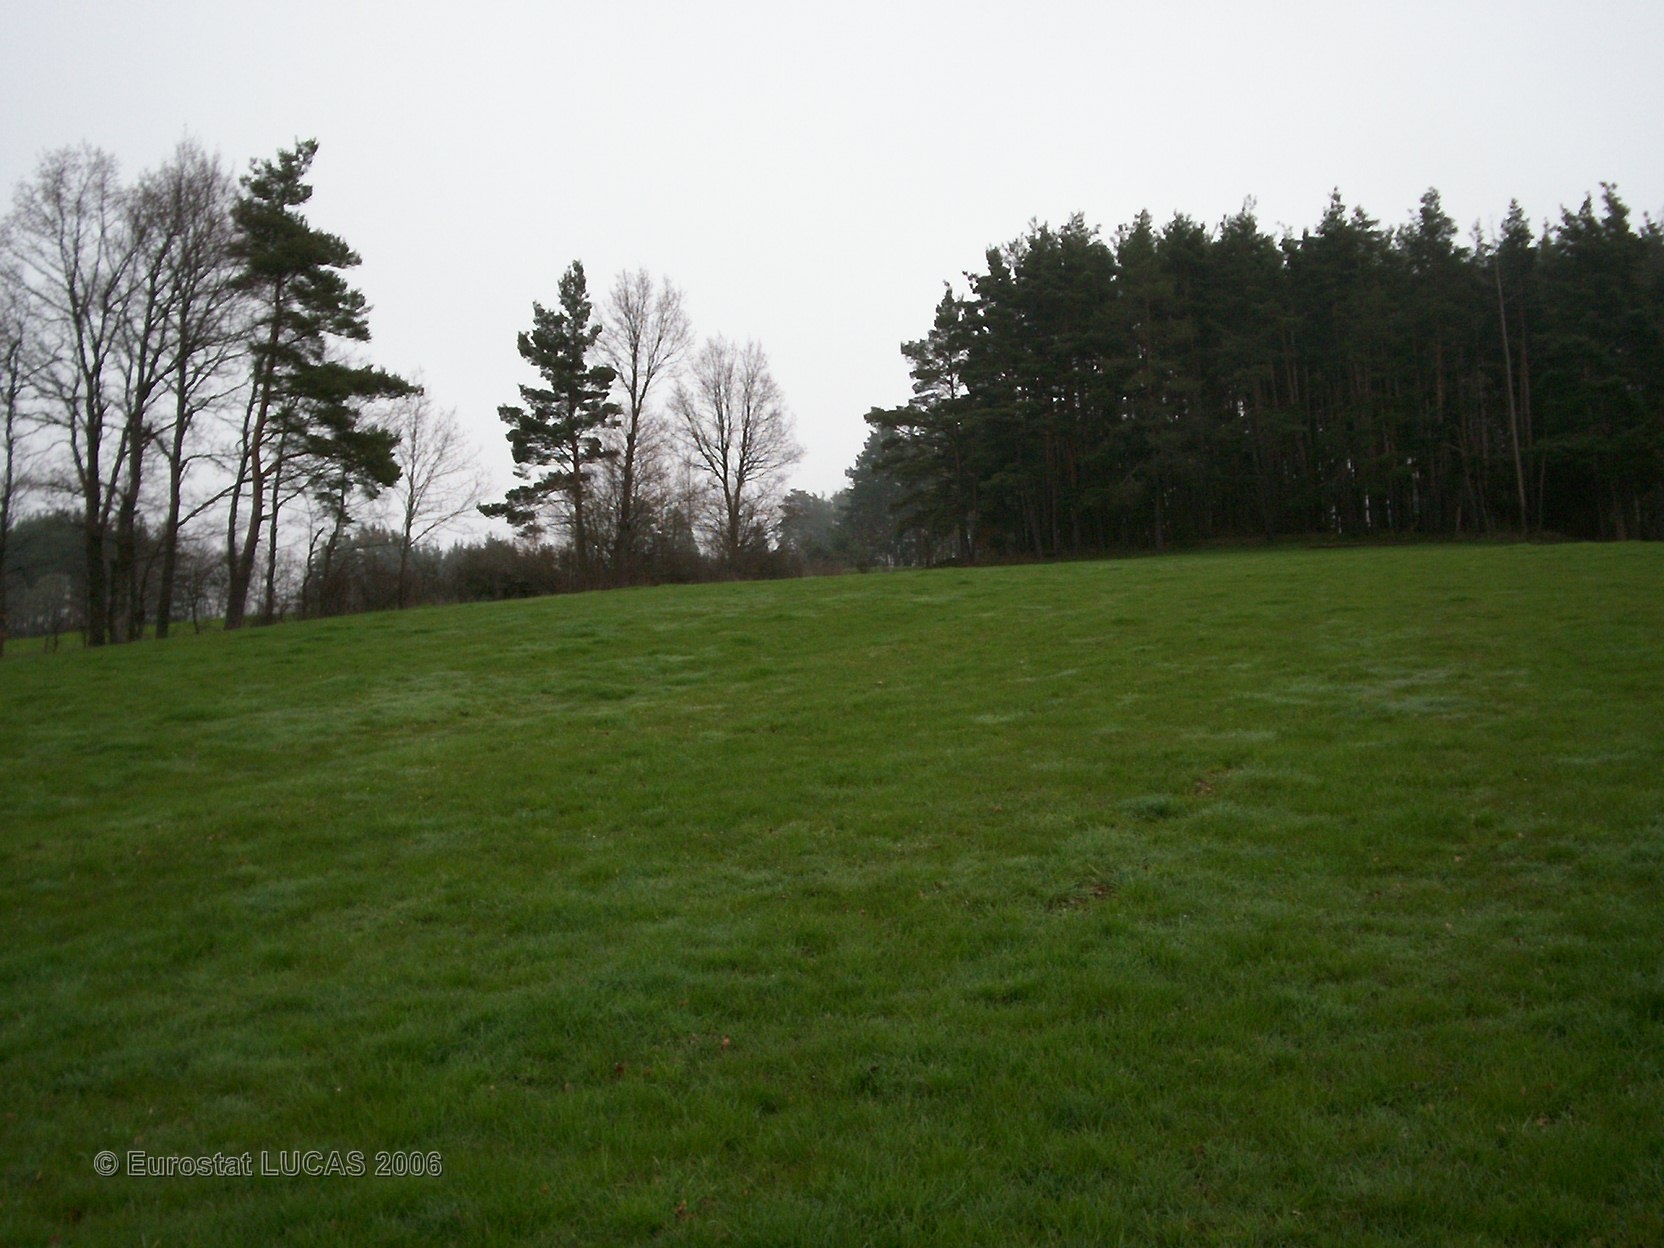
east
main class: Grassland
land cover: Grassland without tree/shrub cover
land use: Agriculture (excluding fallow land and kitchen gardens)
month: April
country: FR
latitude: 44.9462
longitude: 3.2732
